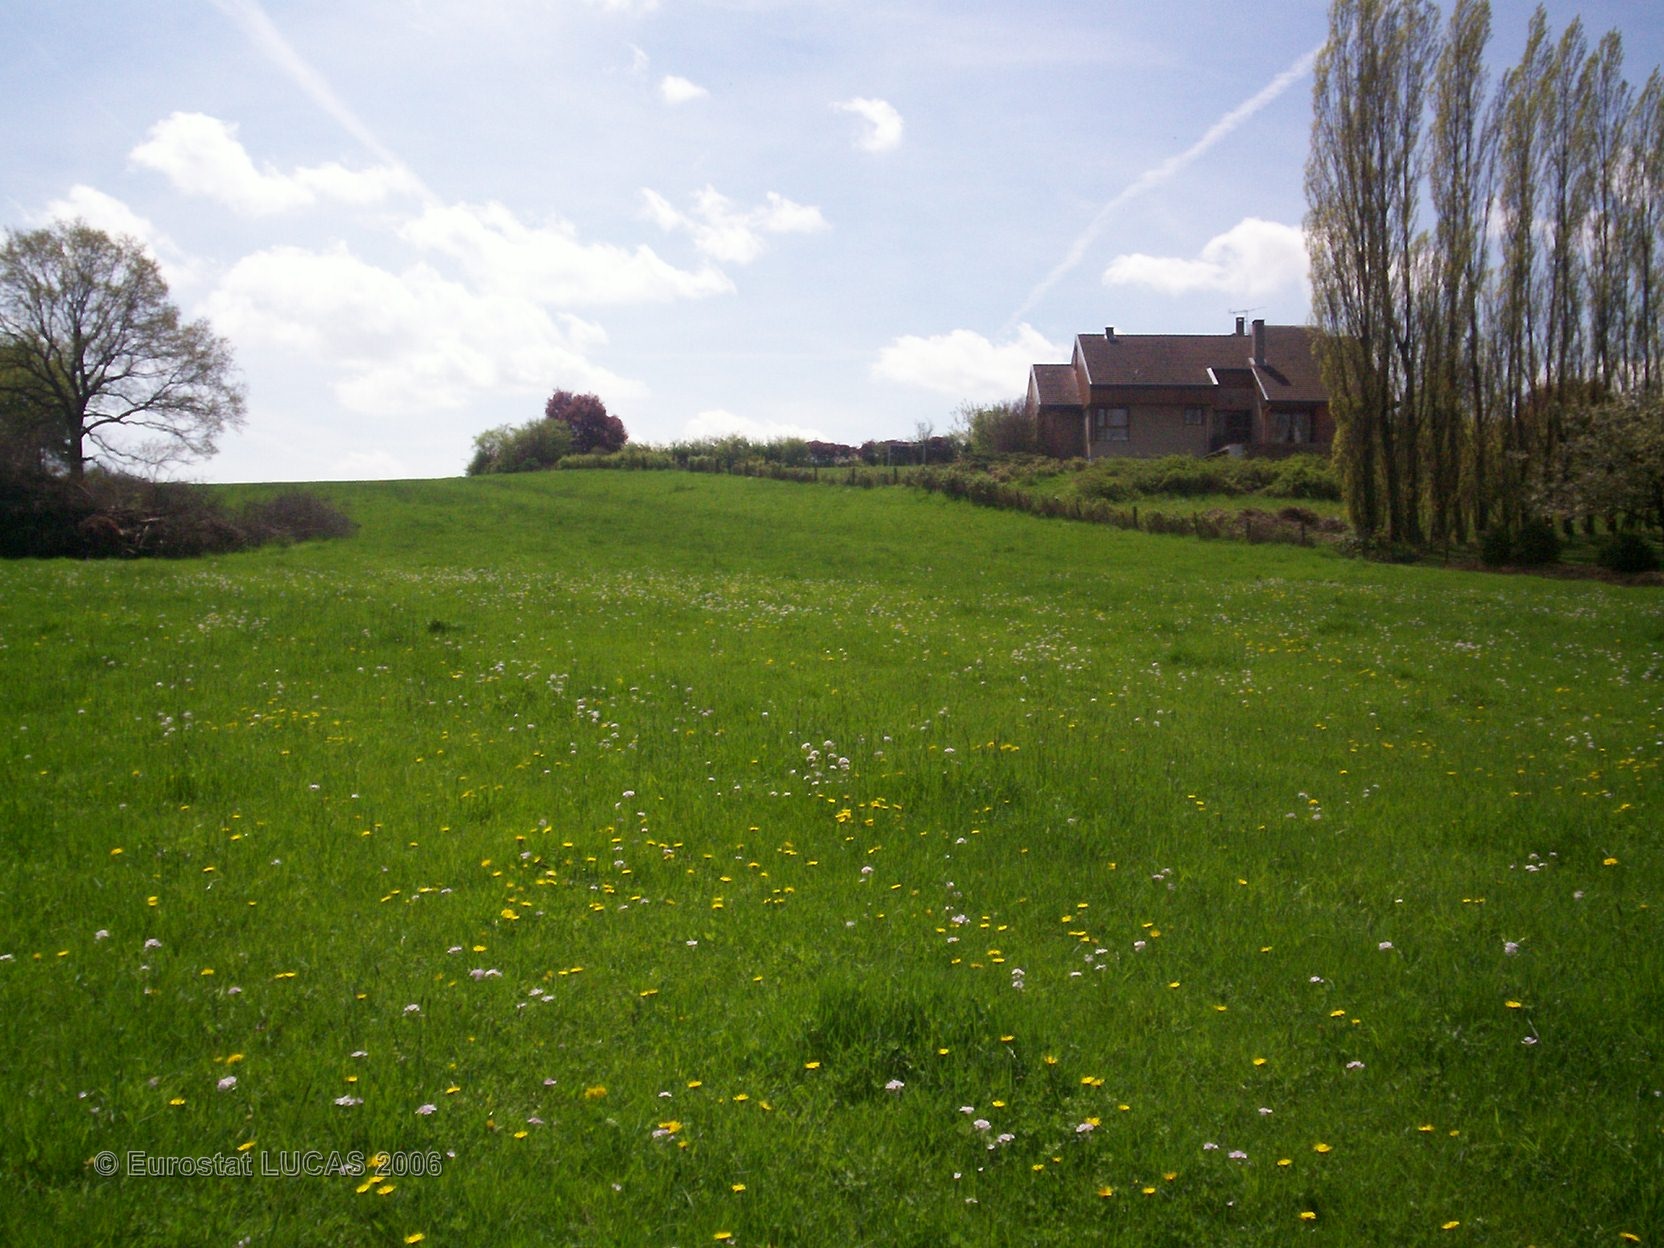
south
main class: Grassland
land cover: Grassland without tree/shrub cover
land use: Agriculture (excluding fallow land and kitchen gardens)
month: May
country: FR
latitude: 49.0941
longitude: 6.7546
